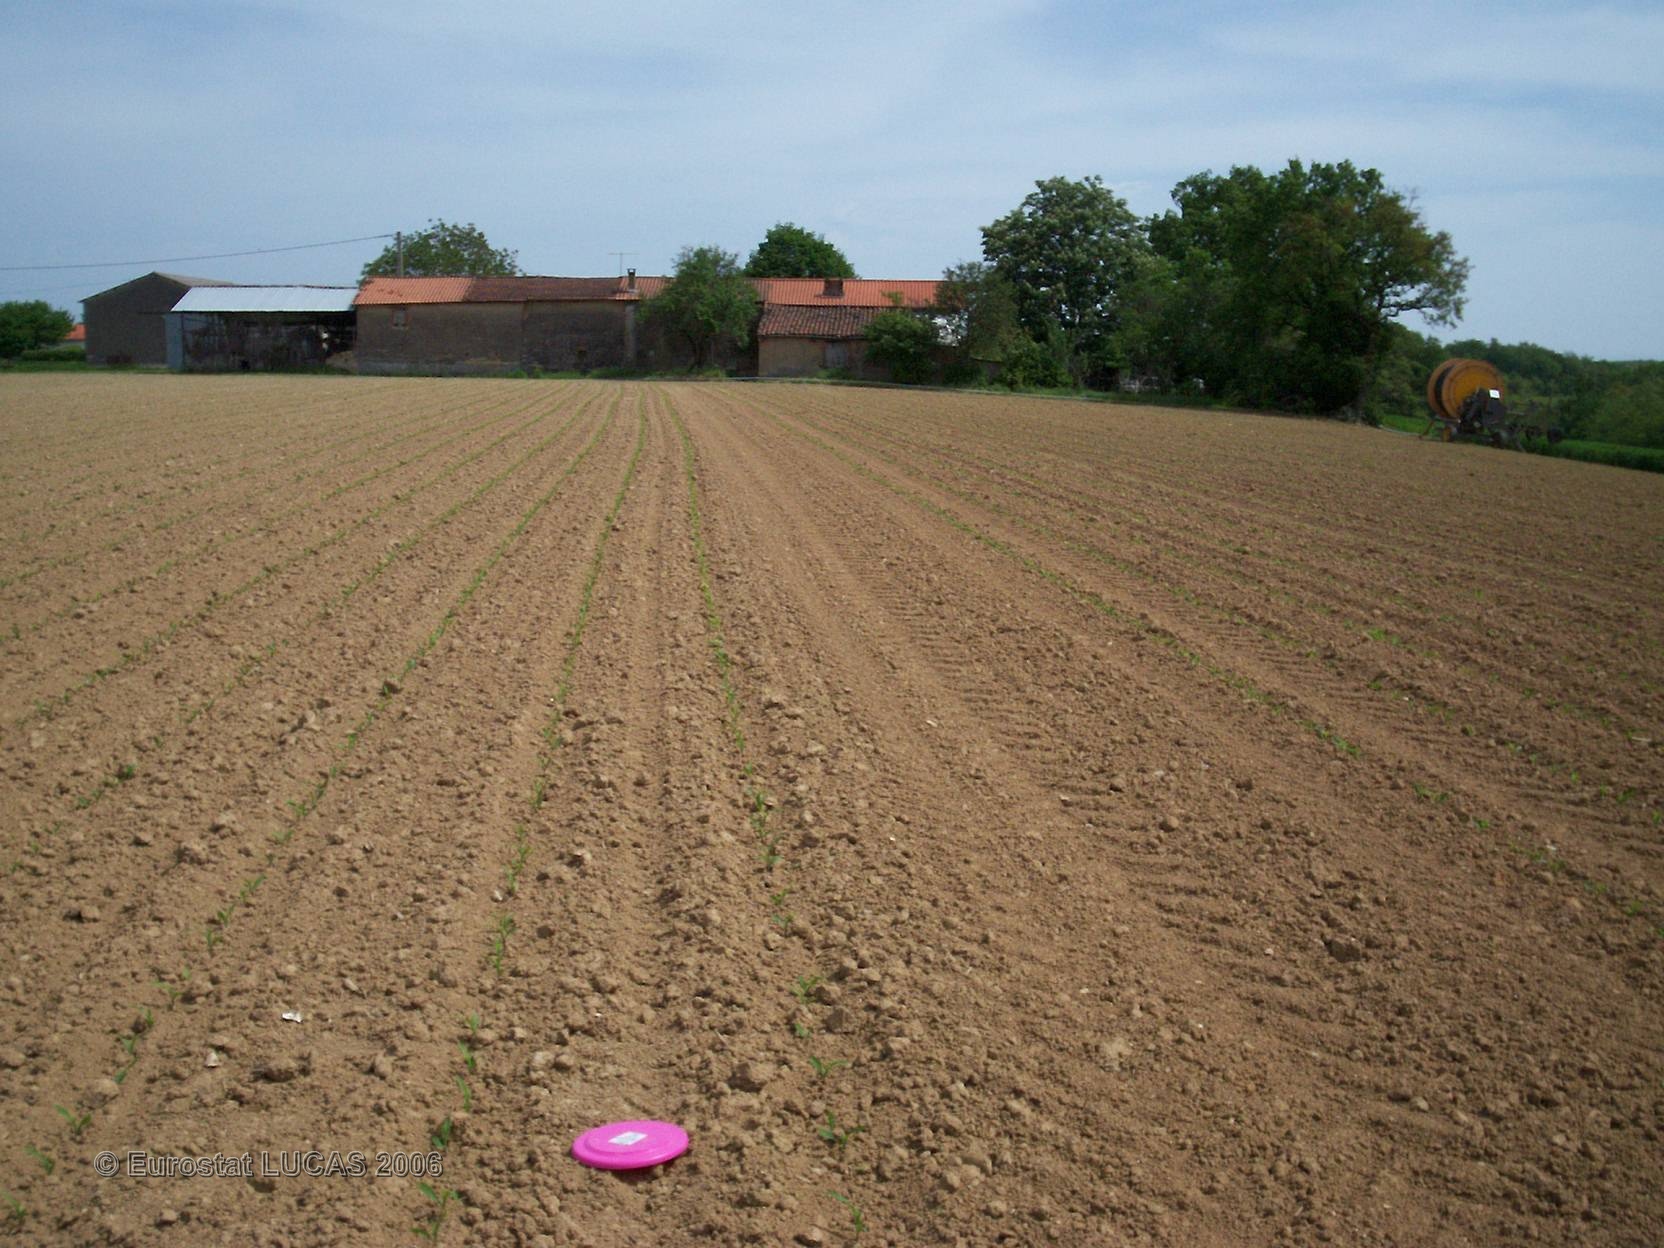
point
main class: Cropland
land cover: Maize
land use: Agriculture (excluding fallow land and kitchen gardens)
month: May
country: FR
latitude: 43.8784
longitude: 2.0011
